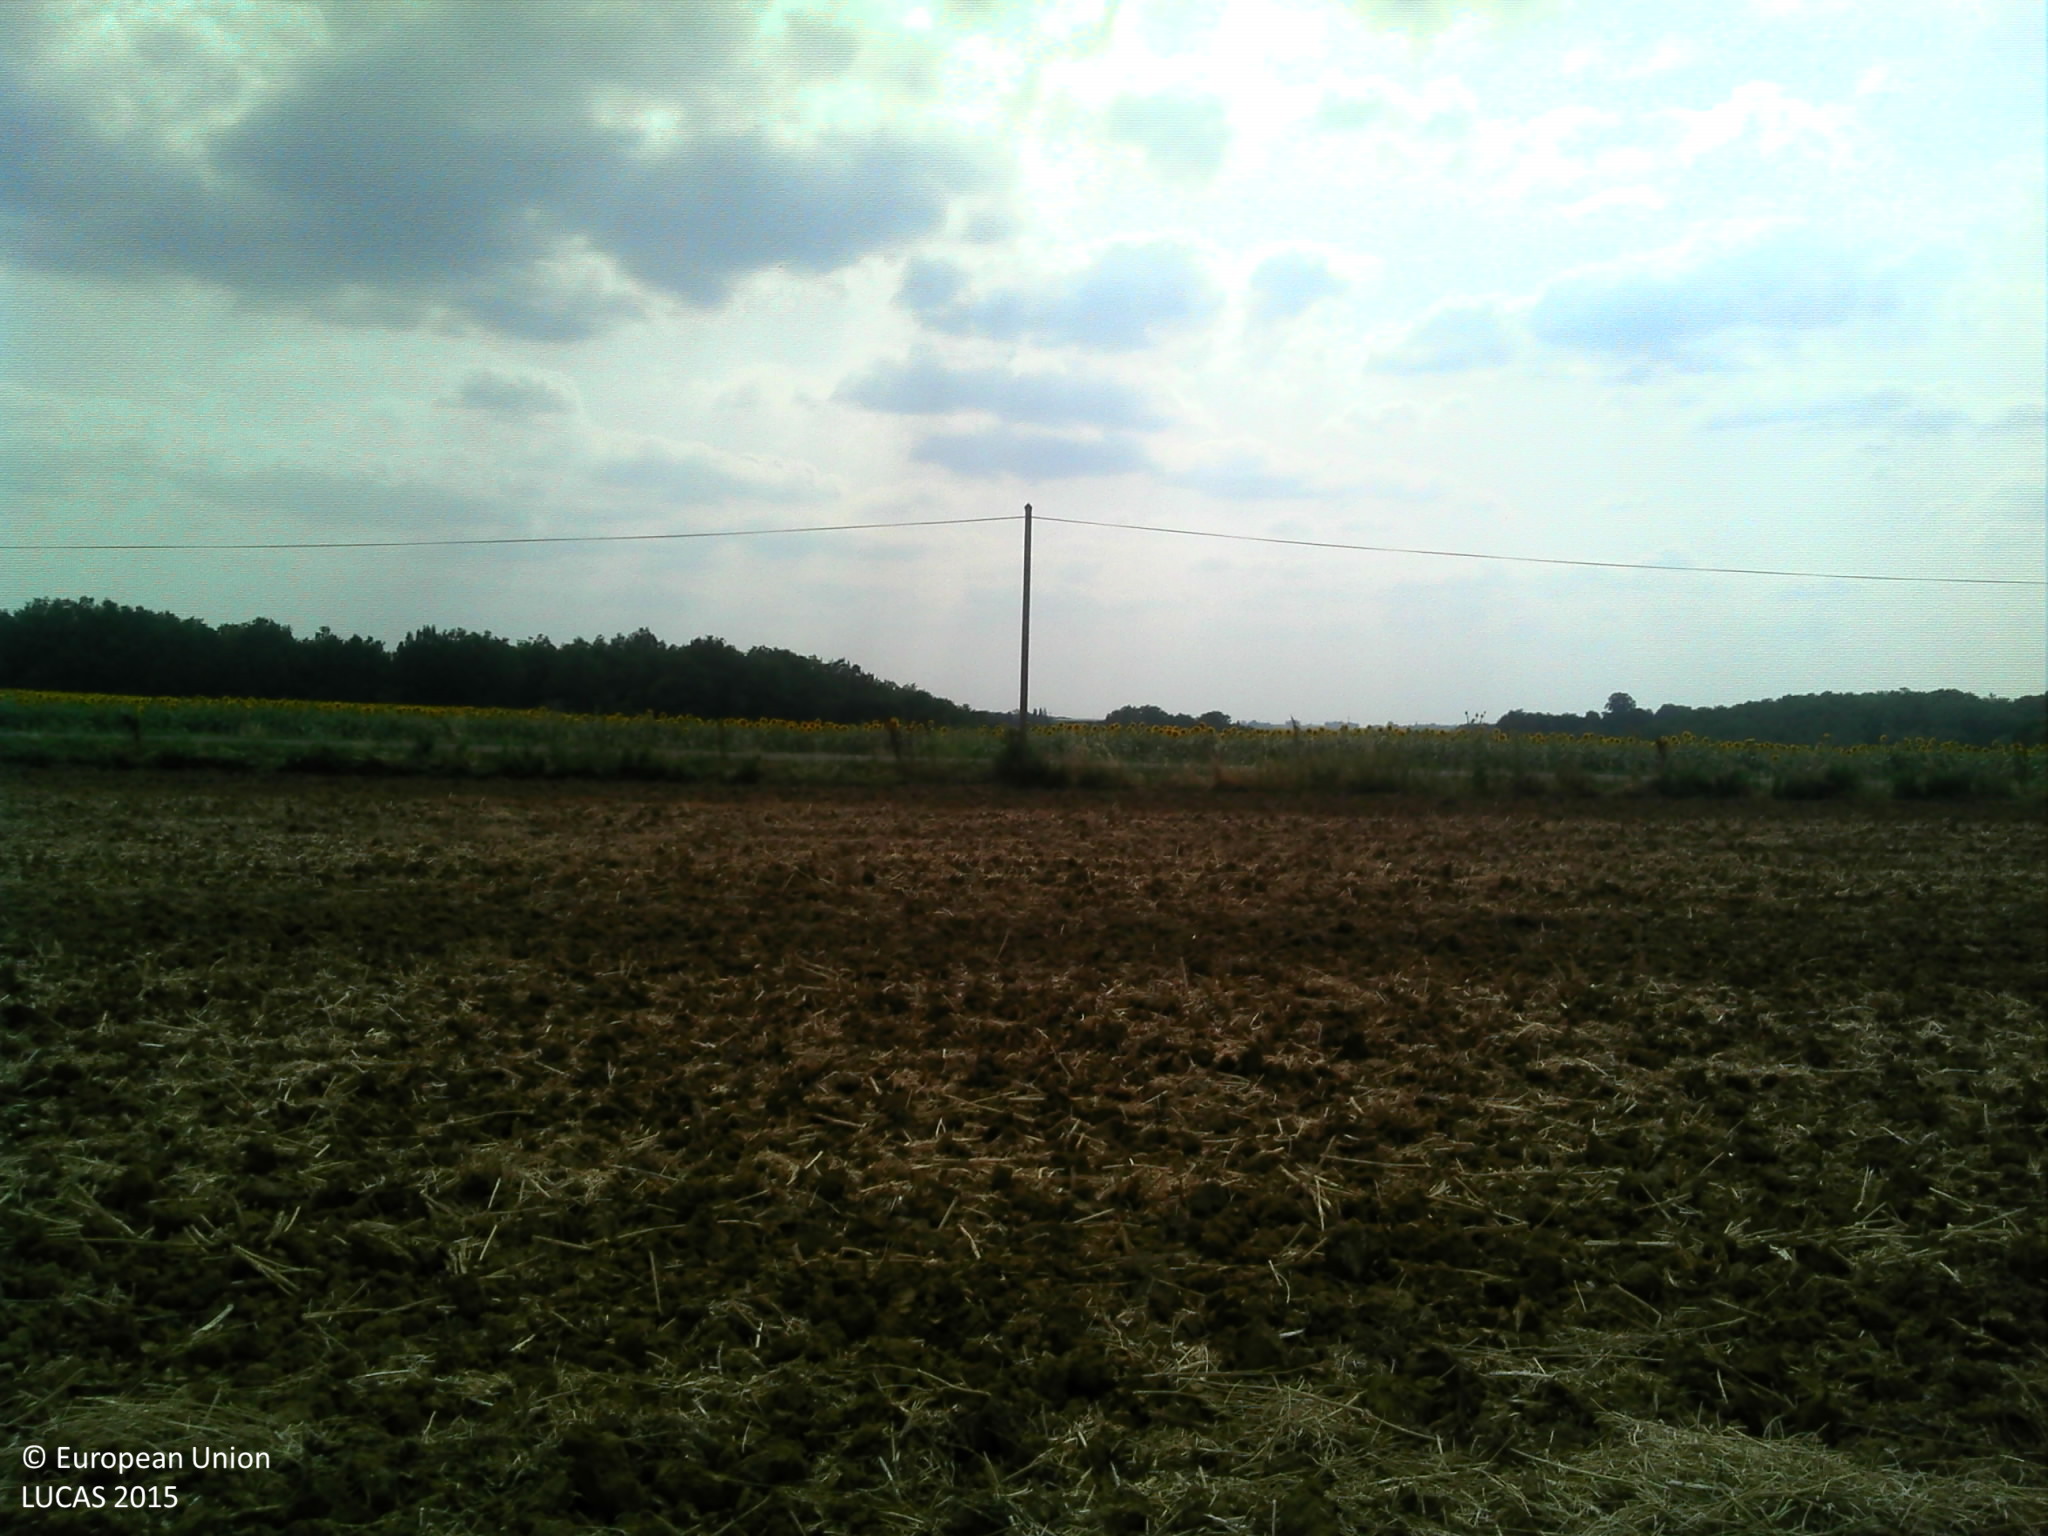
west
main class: Cropland
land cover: Rape and turnip rape
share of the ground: 10 - 25 %
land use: Agriculture (excluding fallow land and kitchen gardens)
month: July
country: FR
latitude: 44.2619
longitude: 0.9400
